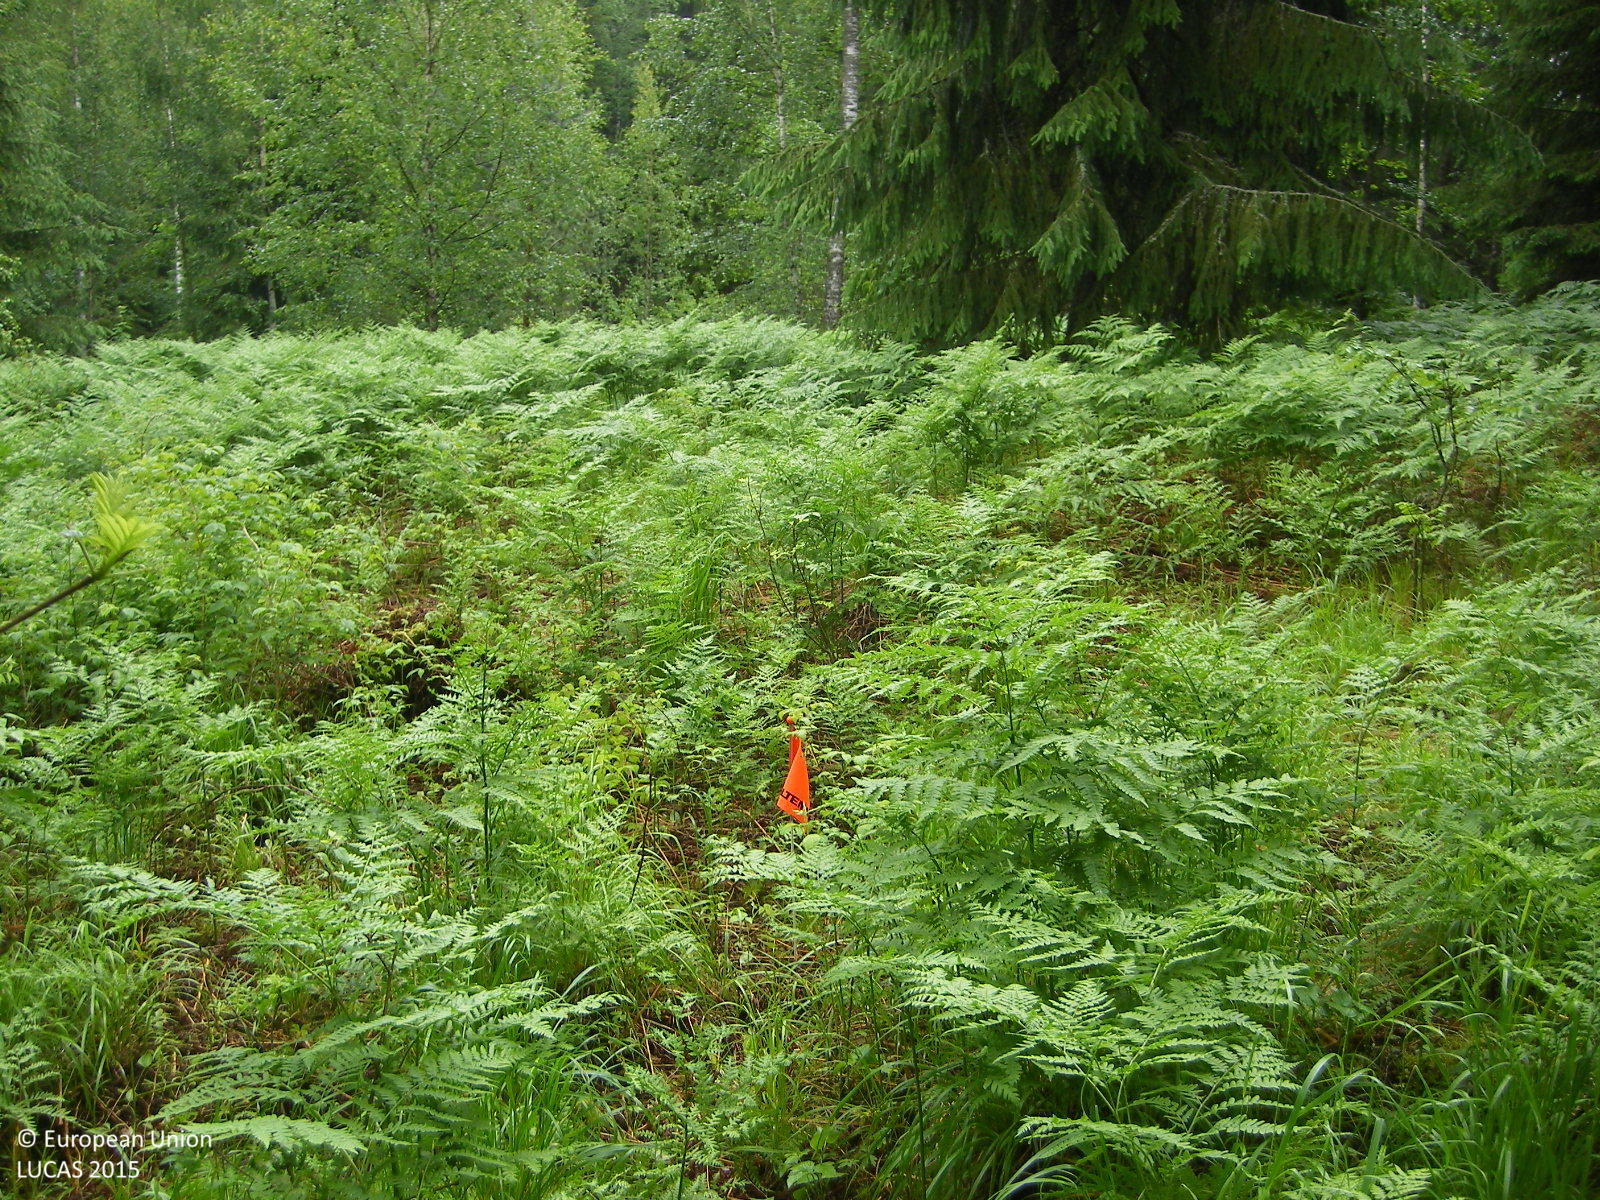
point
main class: Grassland
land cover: Spontaneously vegetated surfaces
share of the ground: > 75 %
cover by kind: herbaceous plants 100 %
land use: Forestry
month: June
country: FI
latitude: 60.4088
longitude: 23.2818
